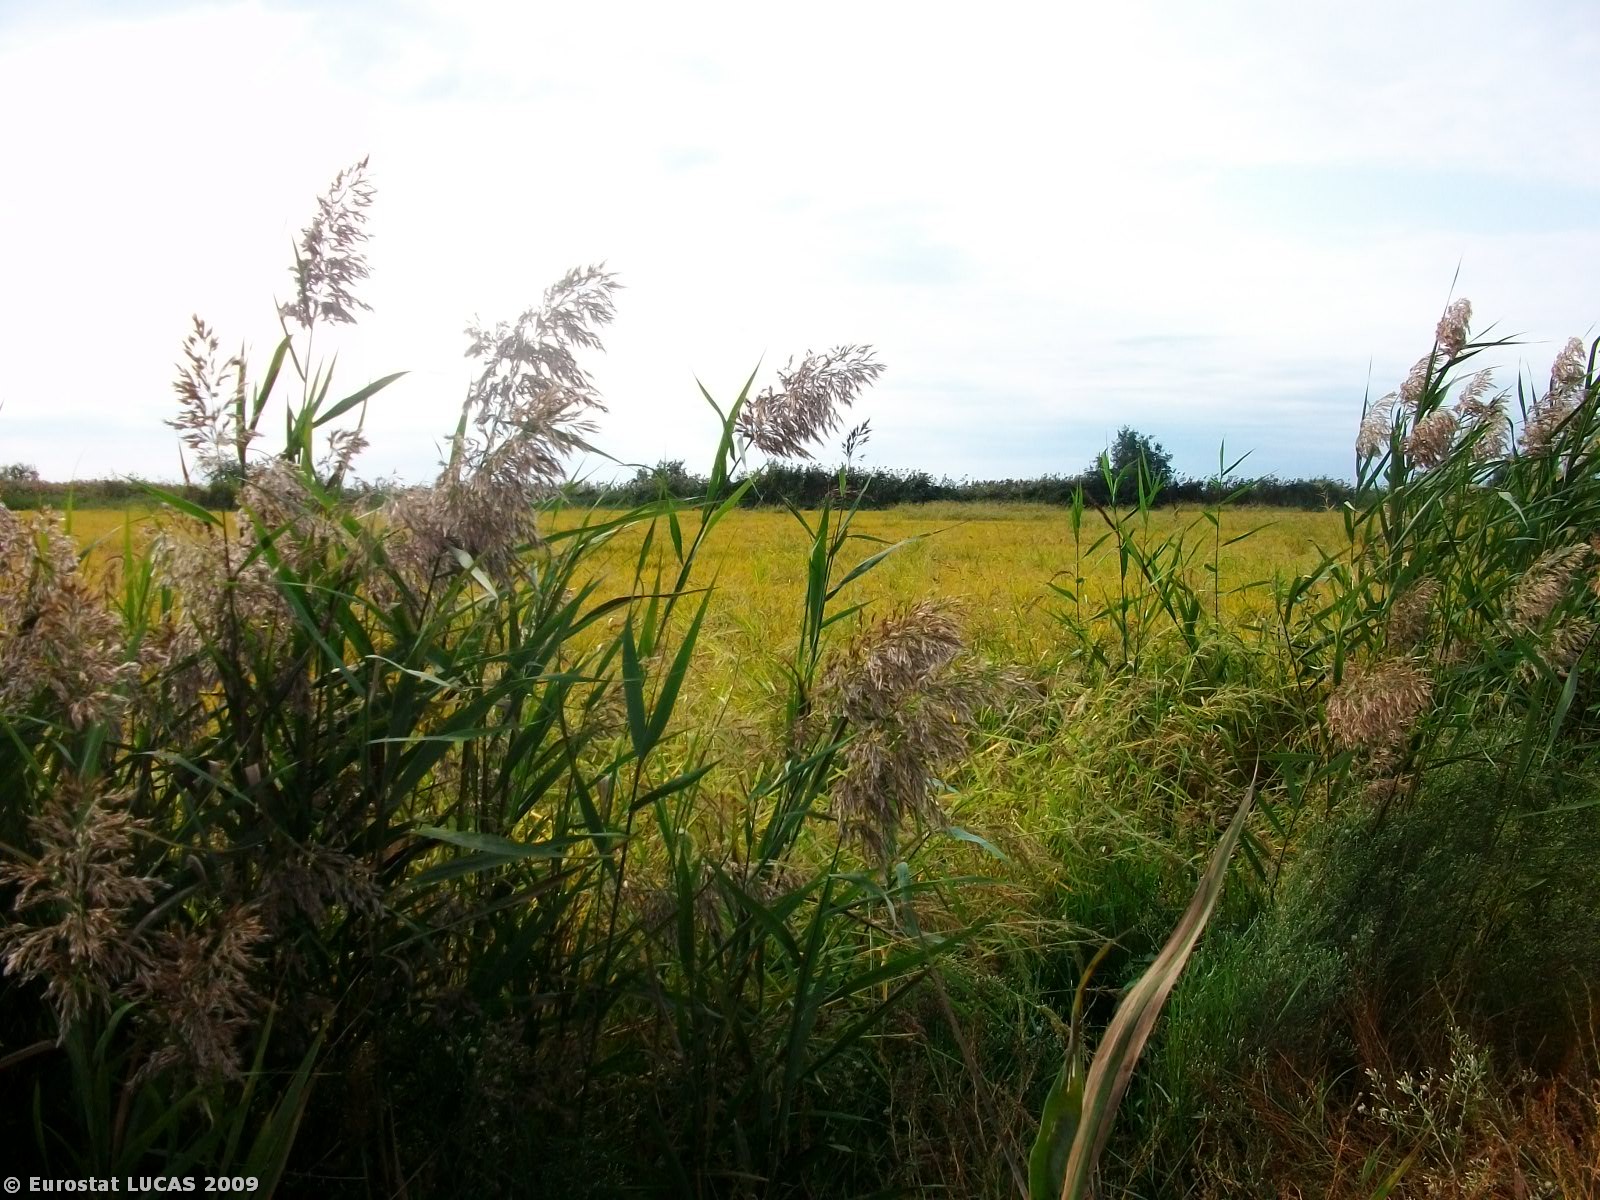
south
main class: Cropland
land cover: Rice
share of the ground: > 75 %
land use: Agriculture (excluding fallow land and kitchen gardens)
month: June
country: GR
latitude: 40.5275
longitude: 22.6214
